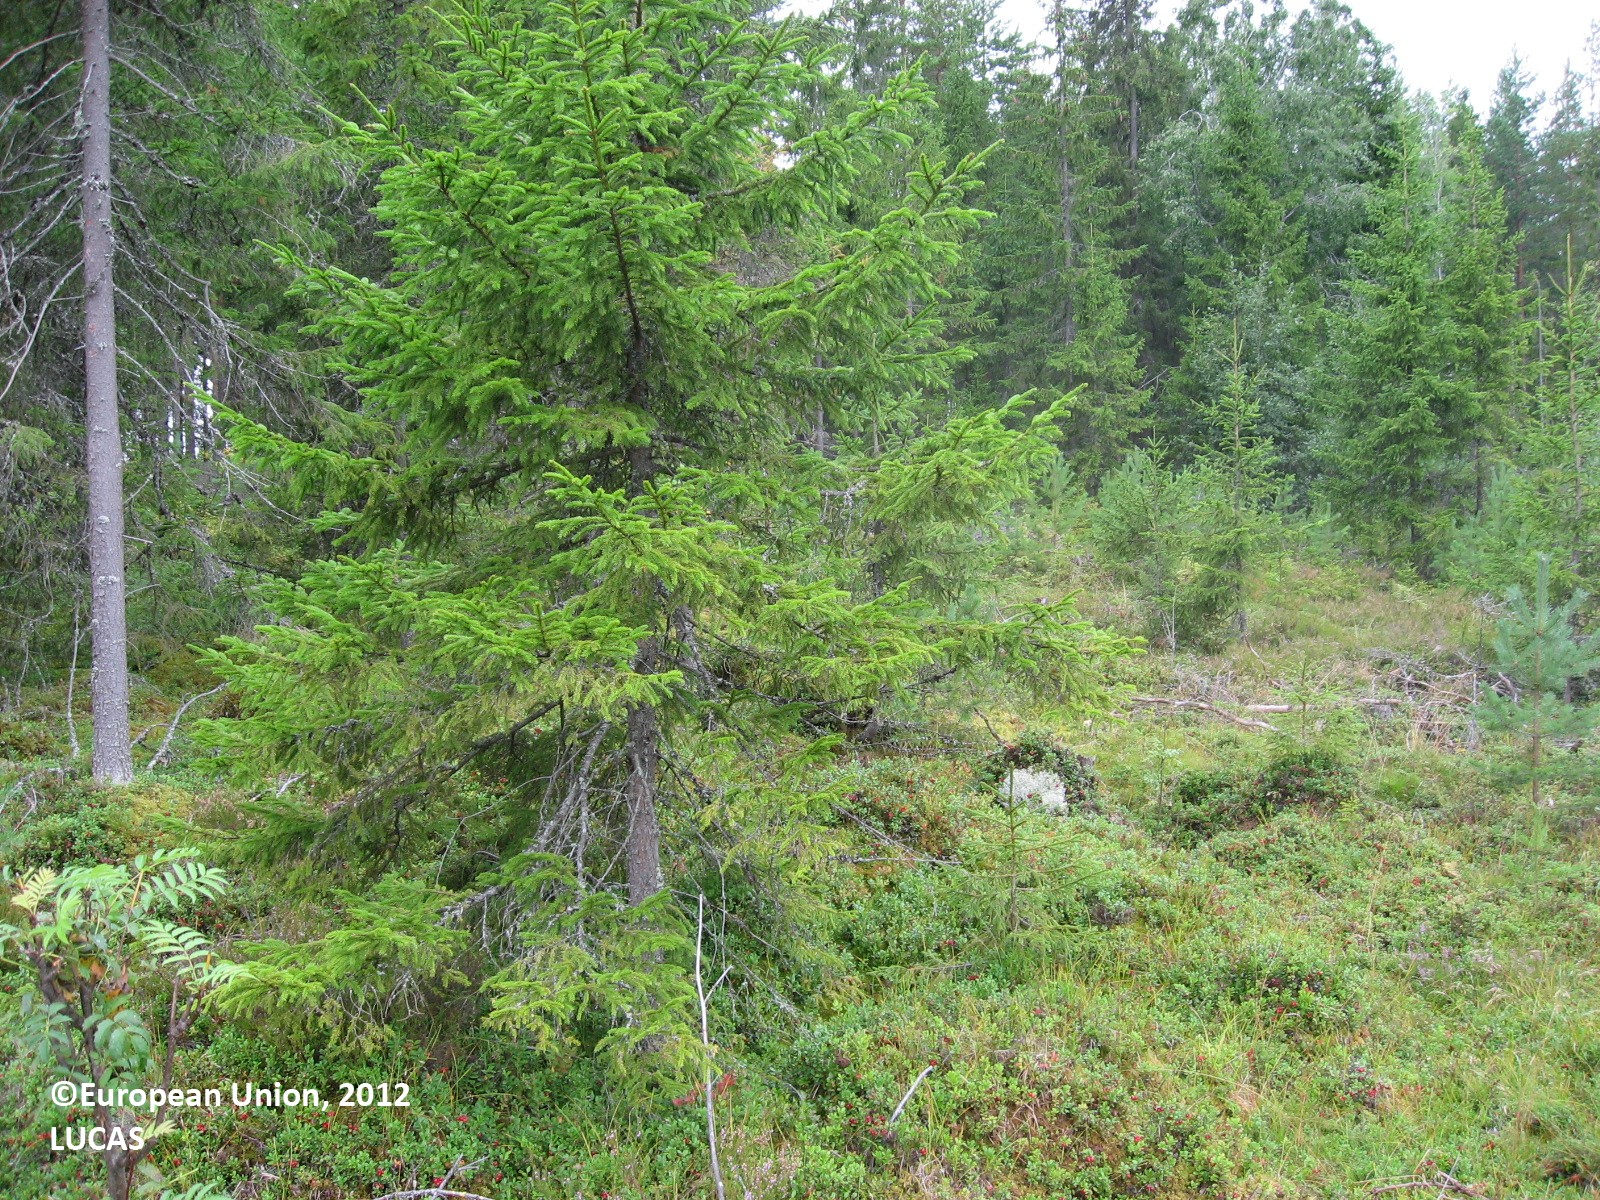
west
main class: Woodland
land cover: Pine dominated mixed woodland
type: boreal forest
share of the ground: 50 - 75 %
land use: Forestry
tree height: < 5 m
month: August
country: FI
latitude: 61.4877
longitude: 24.8095
